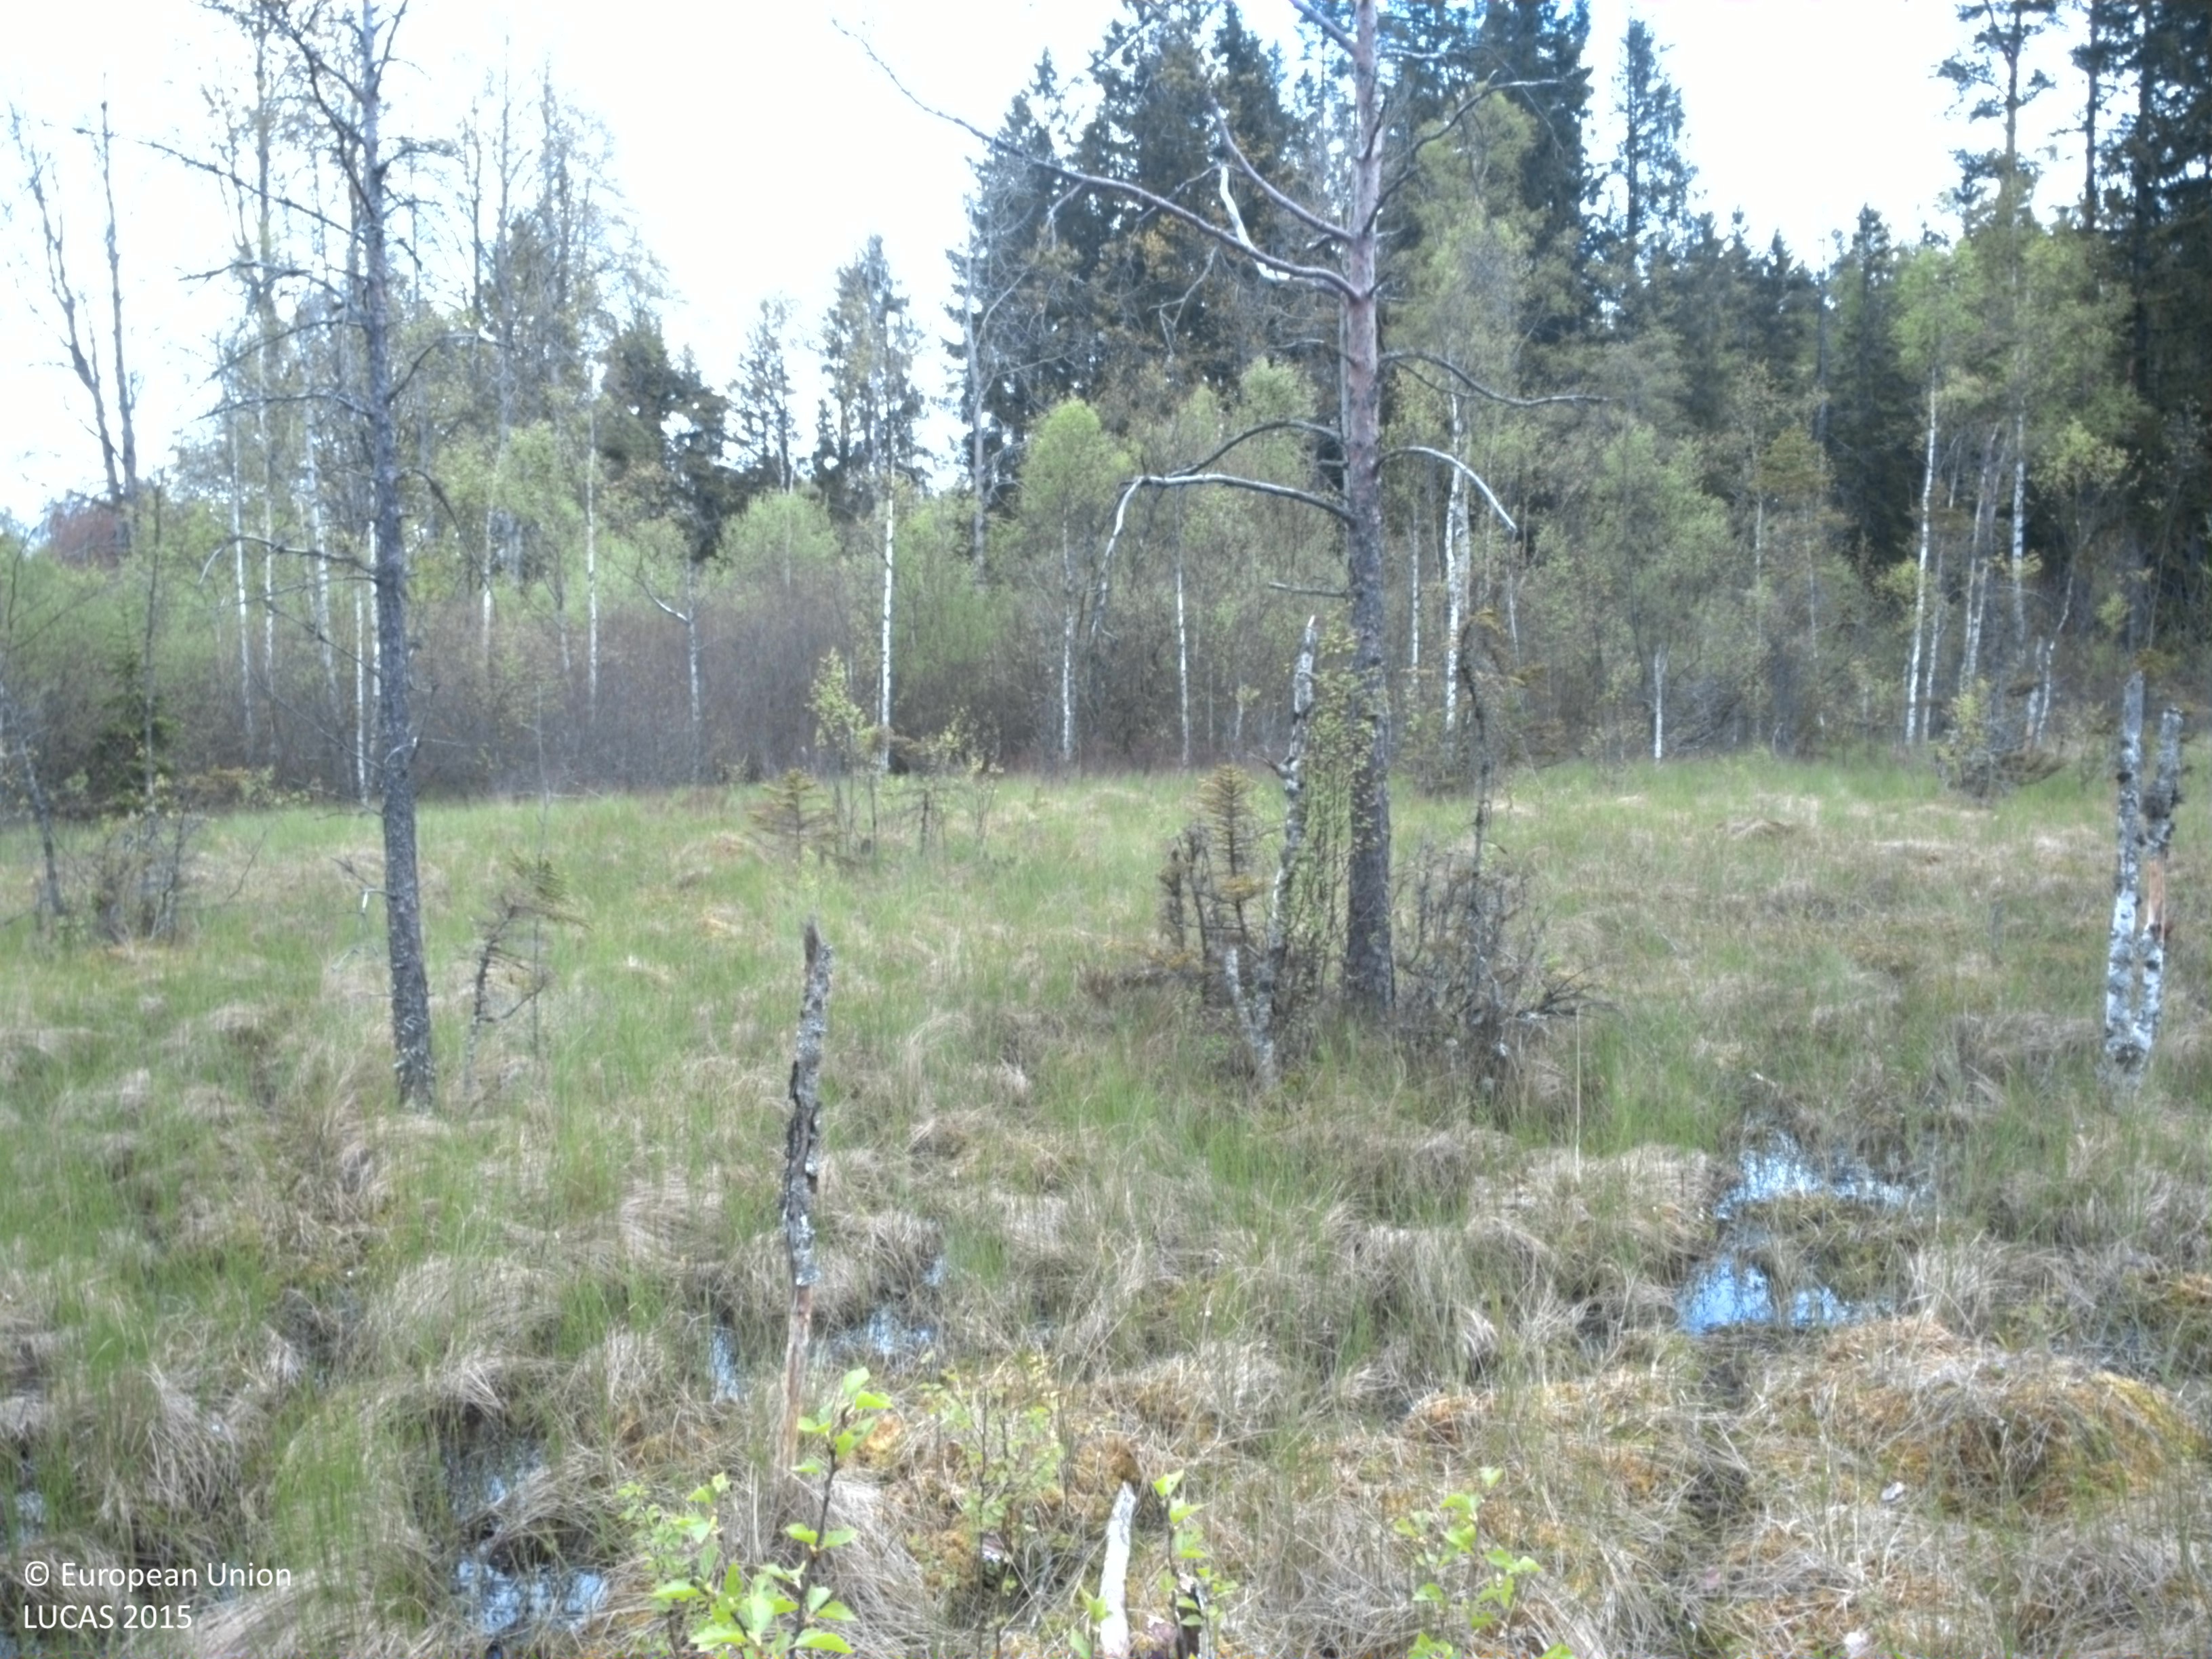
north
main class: Woodland
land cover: Broadleaved woodland
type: hemiboreal forest and nemoral coniferous forest and mixed broadleaved-coniferous forest
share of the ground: 25 - 50 %
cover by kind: broadleaved forest trees 40 %, herbaceous plants 30 %, lichens and mosses 30 %
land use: Forestry
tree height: > 5 m
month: May
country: SE
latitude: 56.8109
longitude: 15.4527
